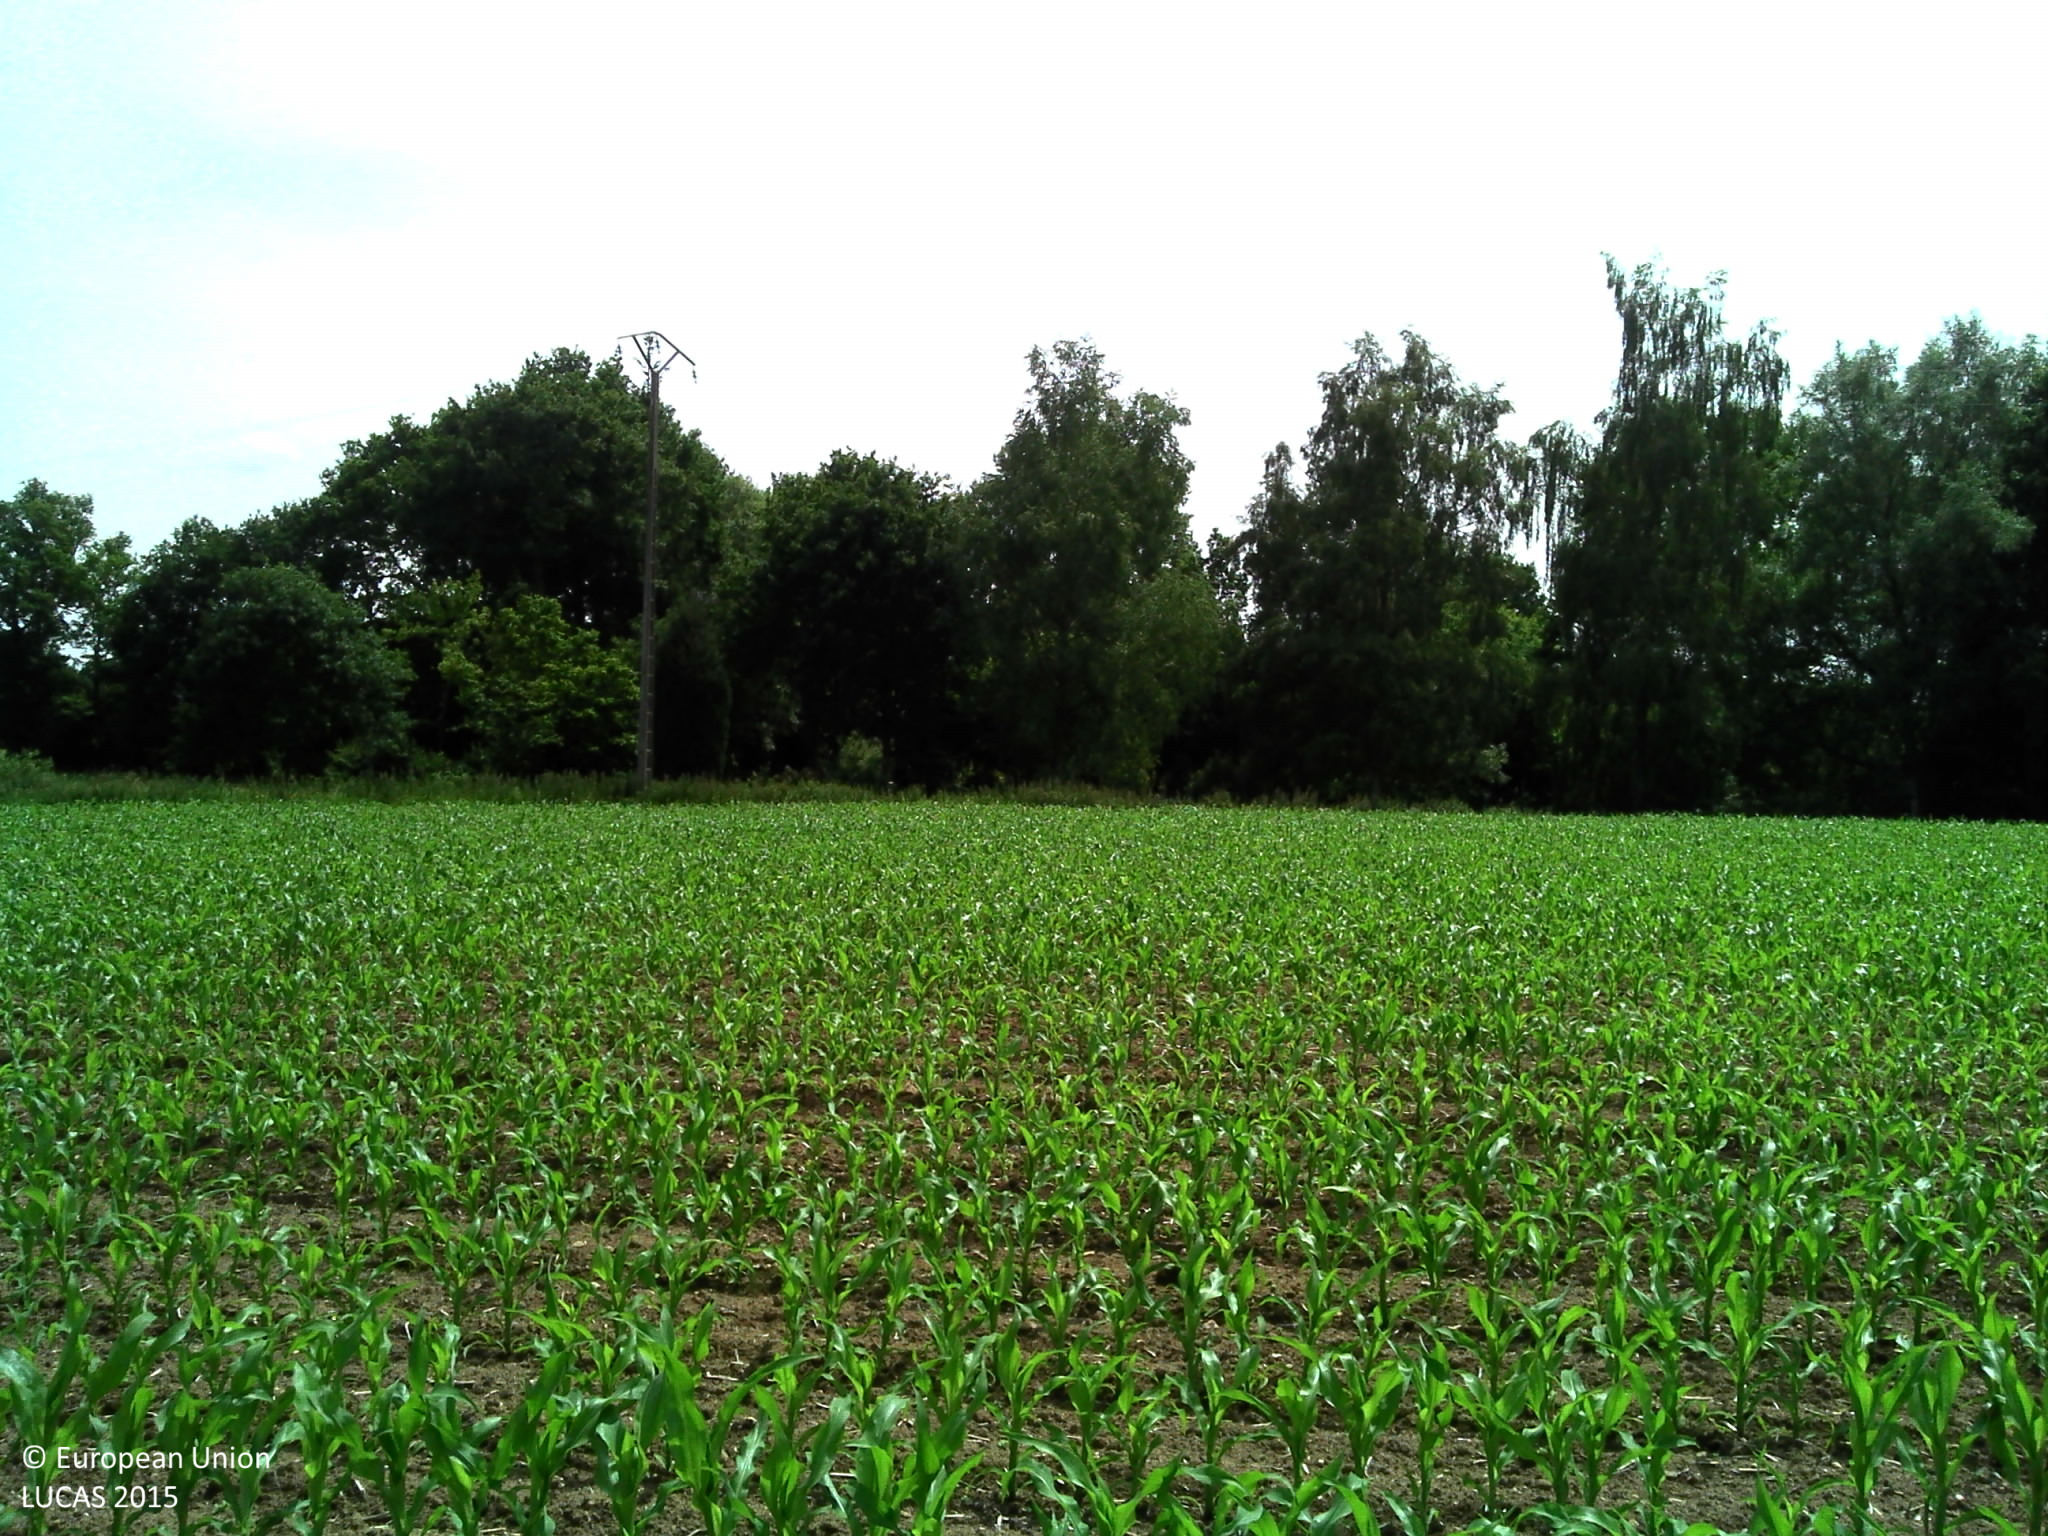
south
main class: Cropland
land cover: Maize
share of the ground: 25 - 50 %
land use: Agriculture (excluding fallow land and kitchen gardens)
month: June
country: FR
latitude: 48.3257
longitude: -1.5247
